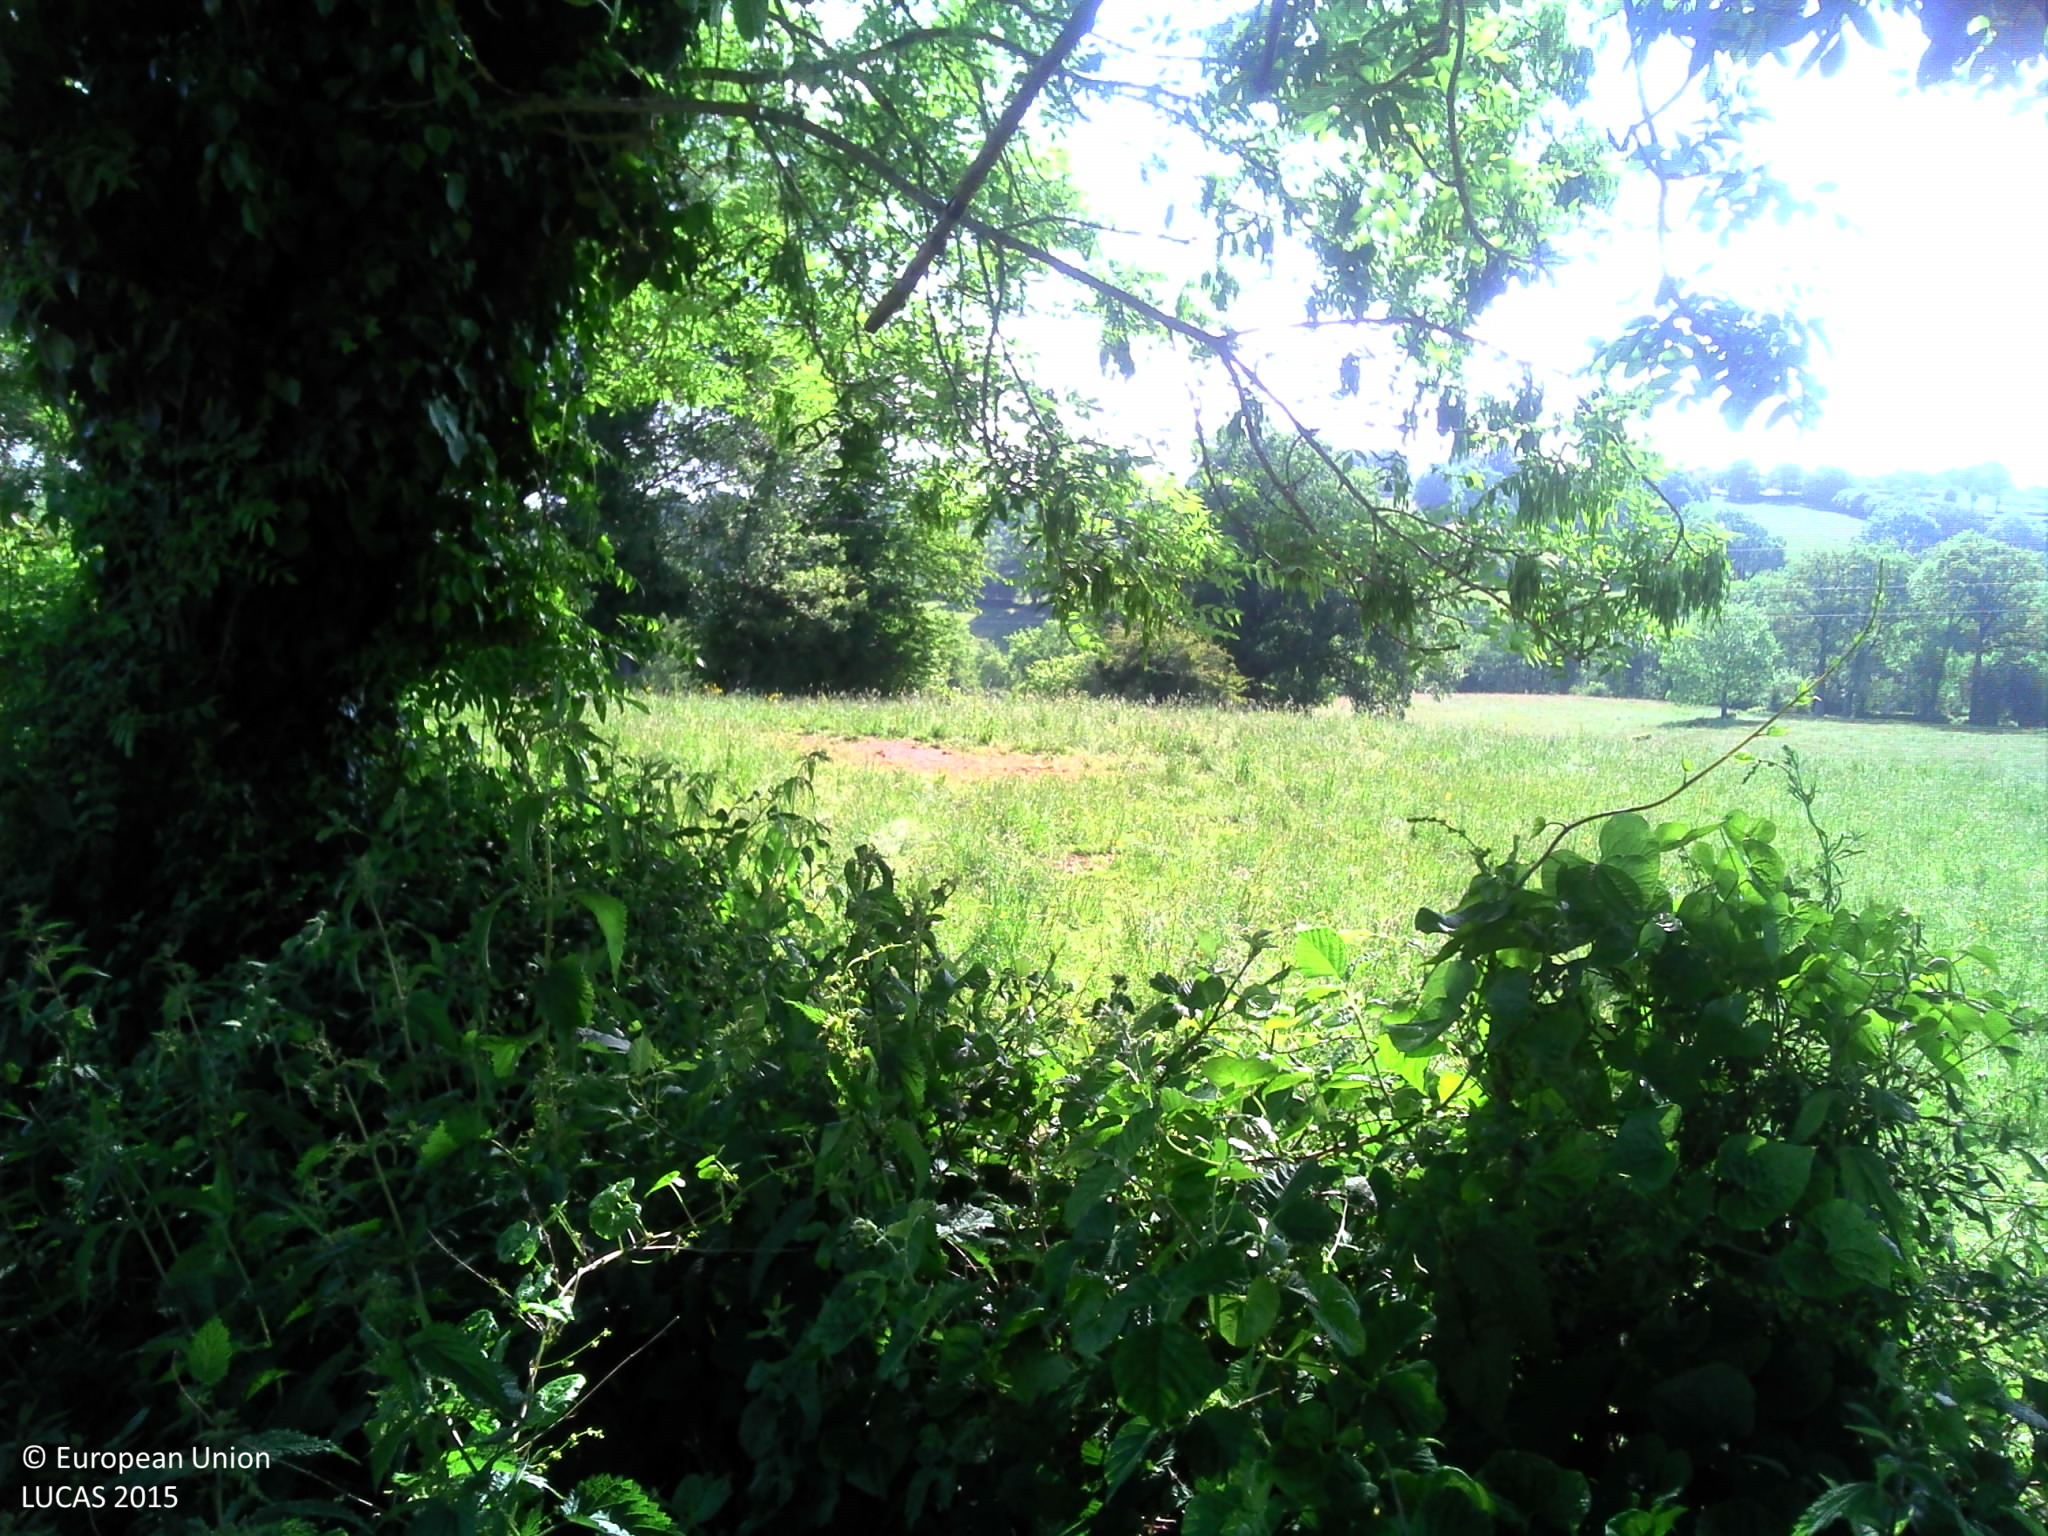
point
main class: Grassland
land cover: Grassland without tree/shrub cover
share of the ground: > 75 %
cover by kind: herbaceous plants 100 %
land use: Agriculture (excluding fallow land and kitchen gardens)
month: May
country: FR
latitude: 46.2315
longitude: 2.7487
